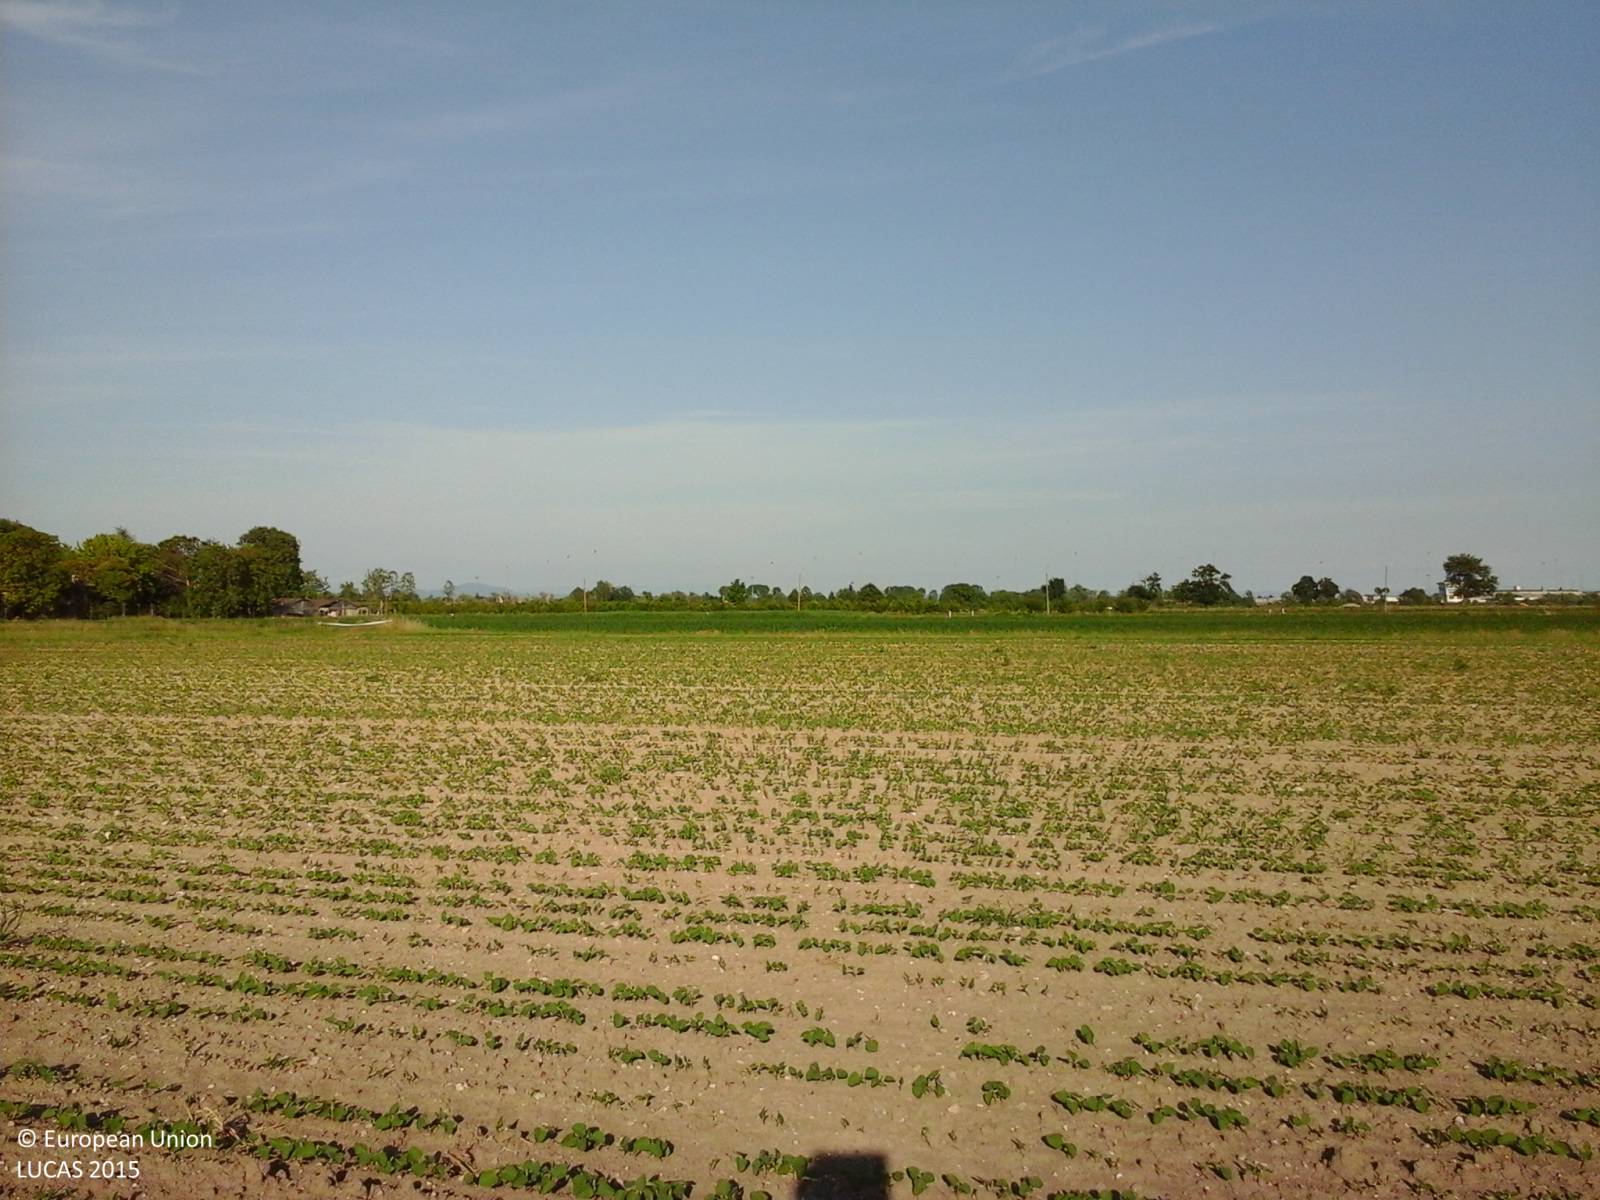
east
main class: Cropland
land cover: Soya
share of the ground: 25 - 50 %
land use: Agriculture (excluding fallow land and kitchen gardens)
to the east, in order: Soya; Grass margins; Tracks; Ditches and canals; Maize; Ditches and canals; Grass margins; Paved roads, cycling and walking lanes; Grass margins; Ditches and canals; Electric lines; Grass margins; Maize
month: June
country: IT
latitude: 45.8494
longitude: 13.3056
